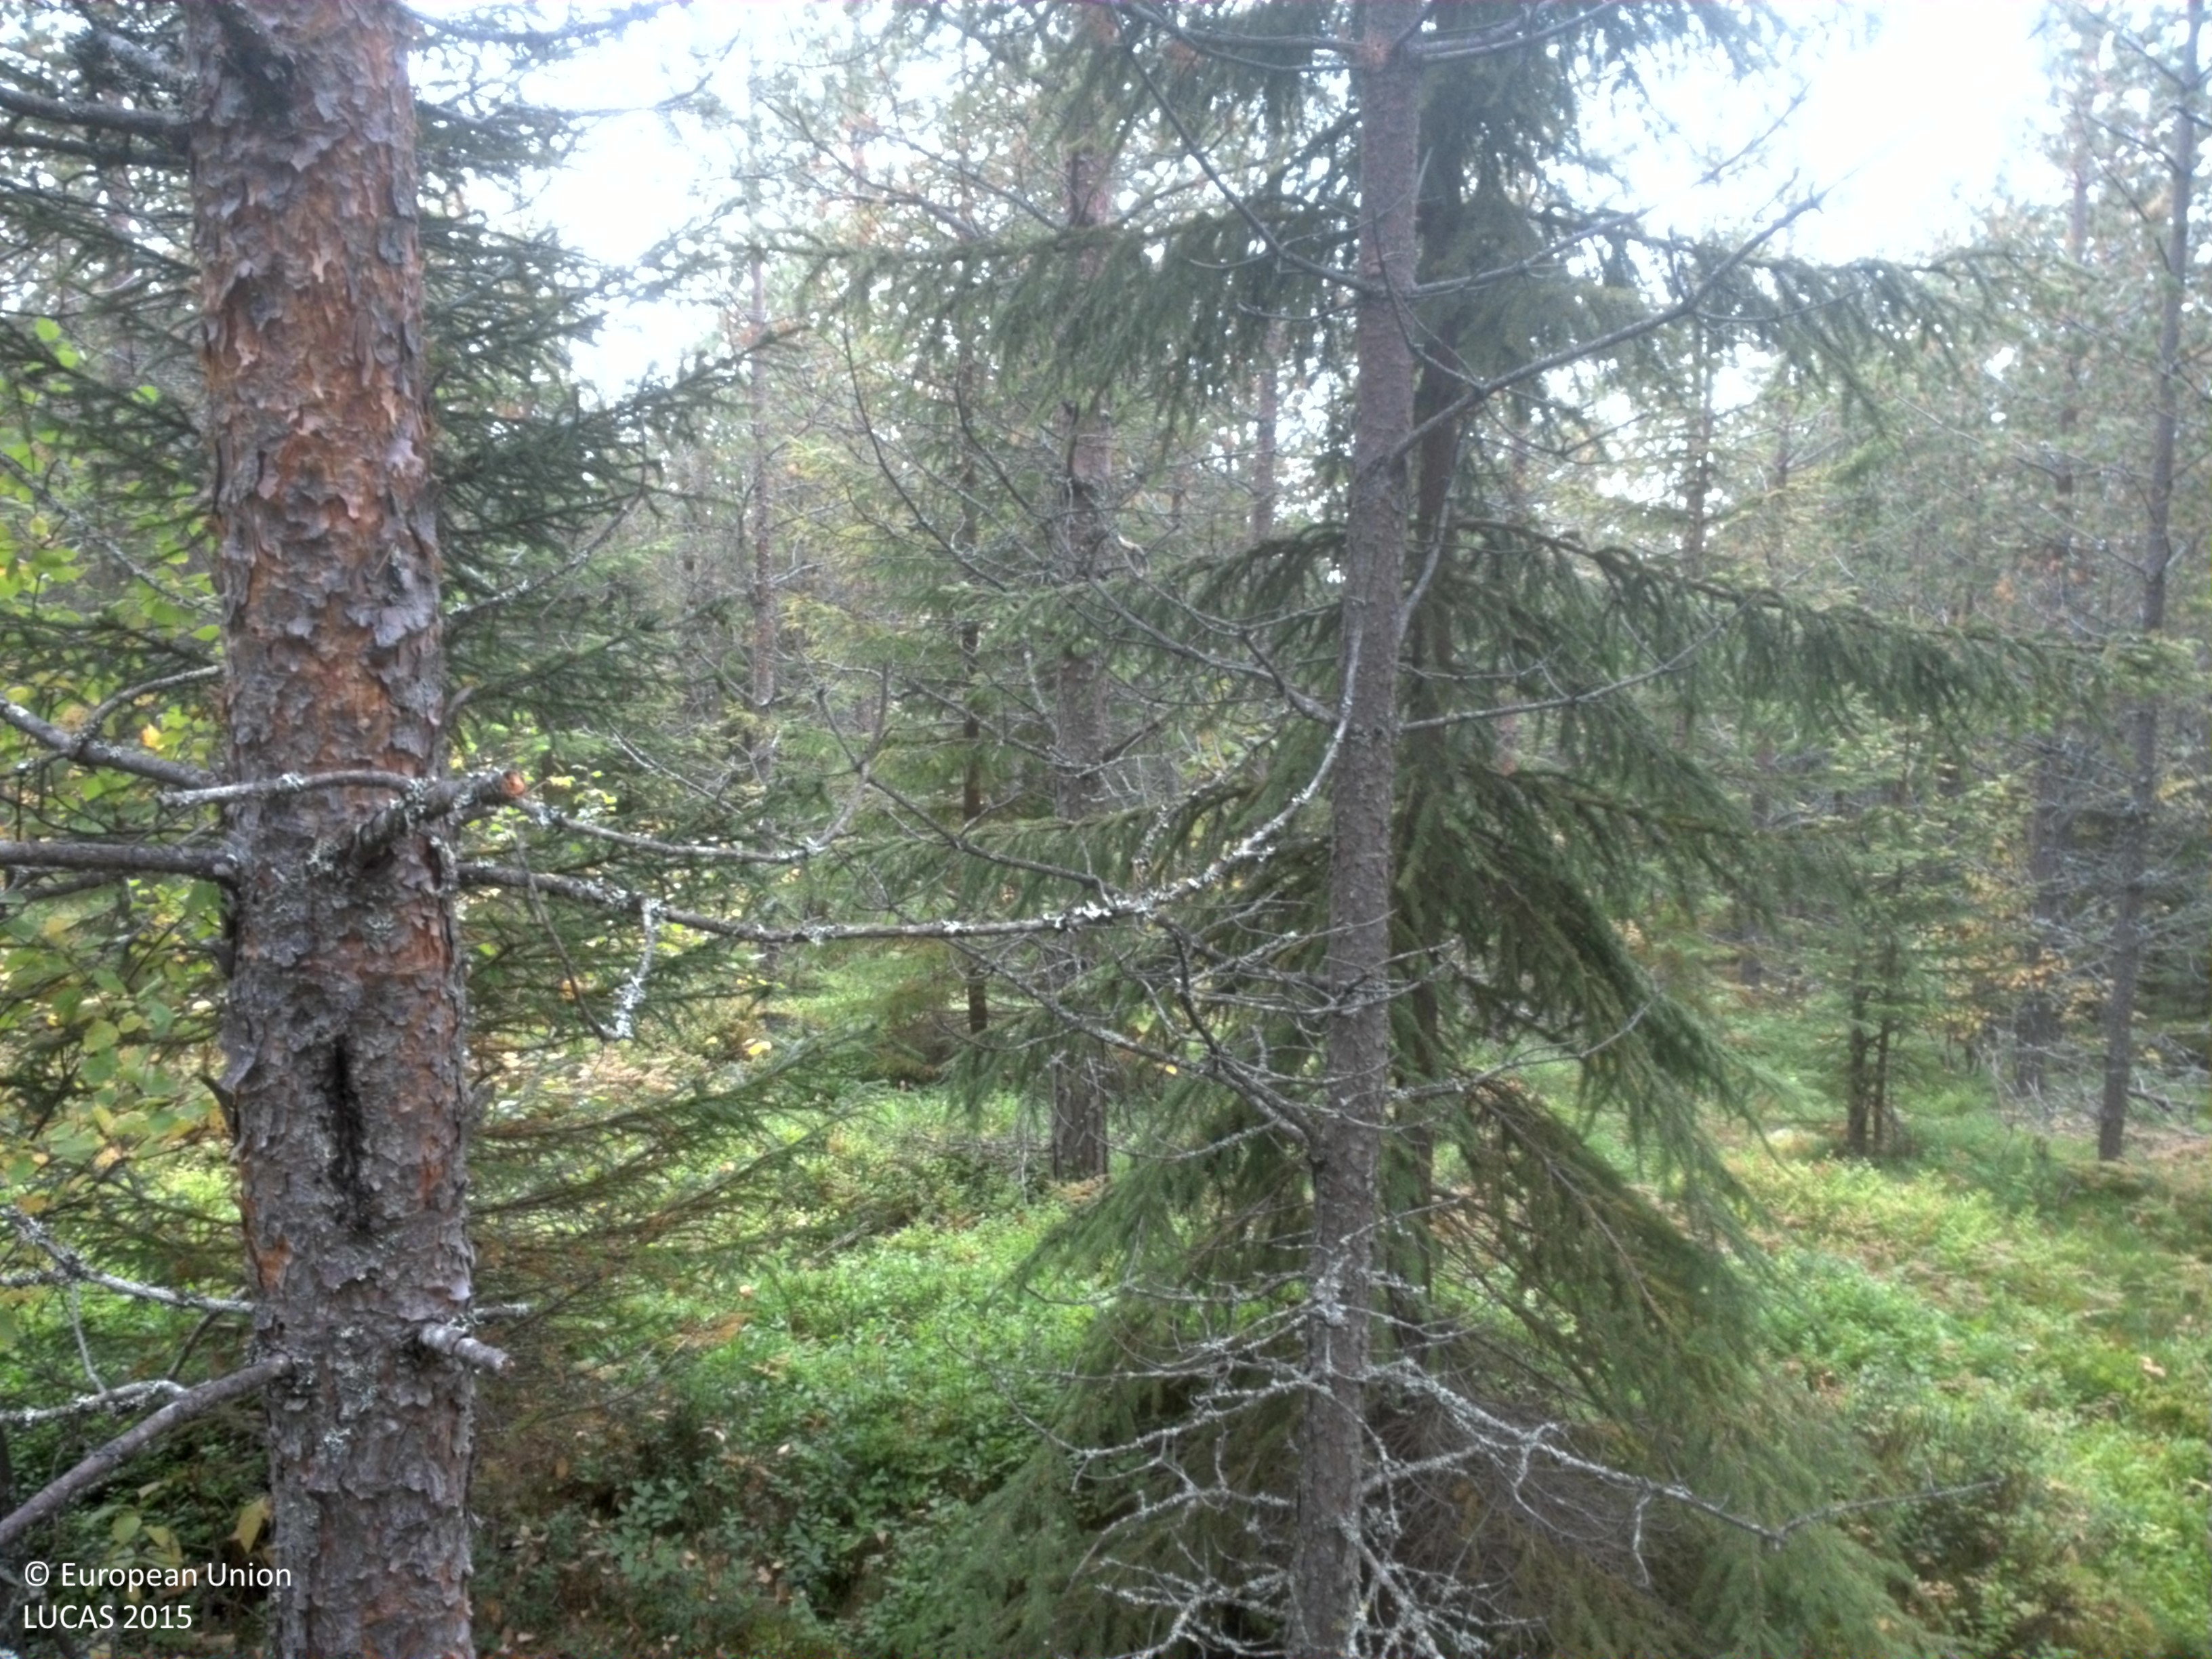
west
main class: Woodland
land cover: Pine dominated coniferous woodland
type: boreal forest
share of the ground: 50 - 75 %
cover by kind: coniferous forest trees 60 %, shrubs 20 %, herbaceous plants 10 %, broadleaved forest trees 5 %, lichens and mosses 5 %
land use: Forestry
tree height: > 5 m
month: September
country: SE
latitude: 64.4302
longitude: 20.2552
